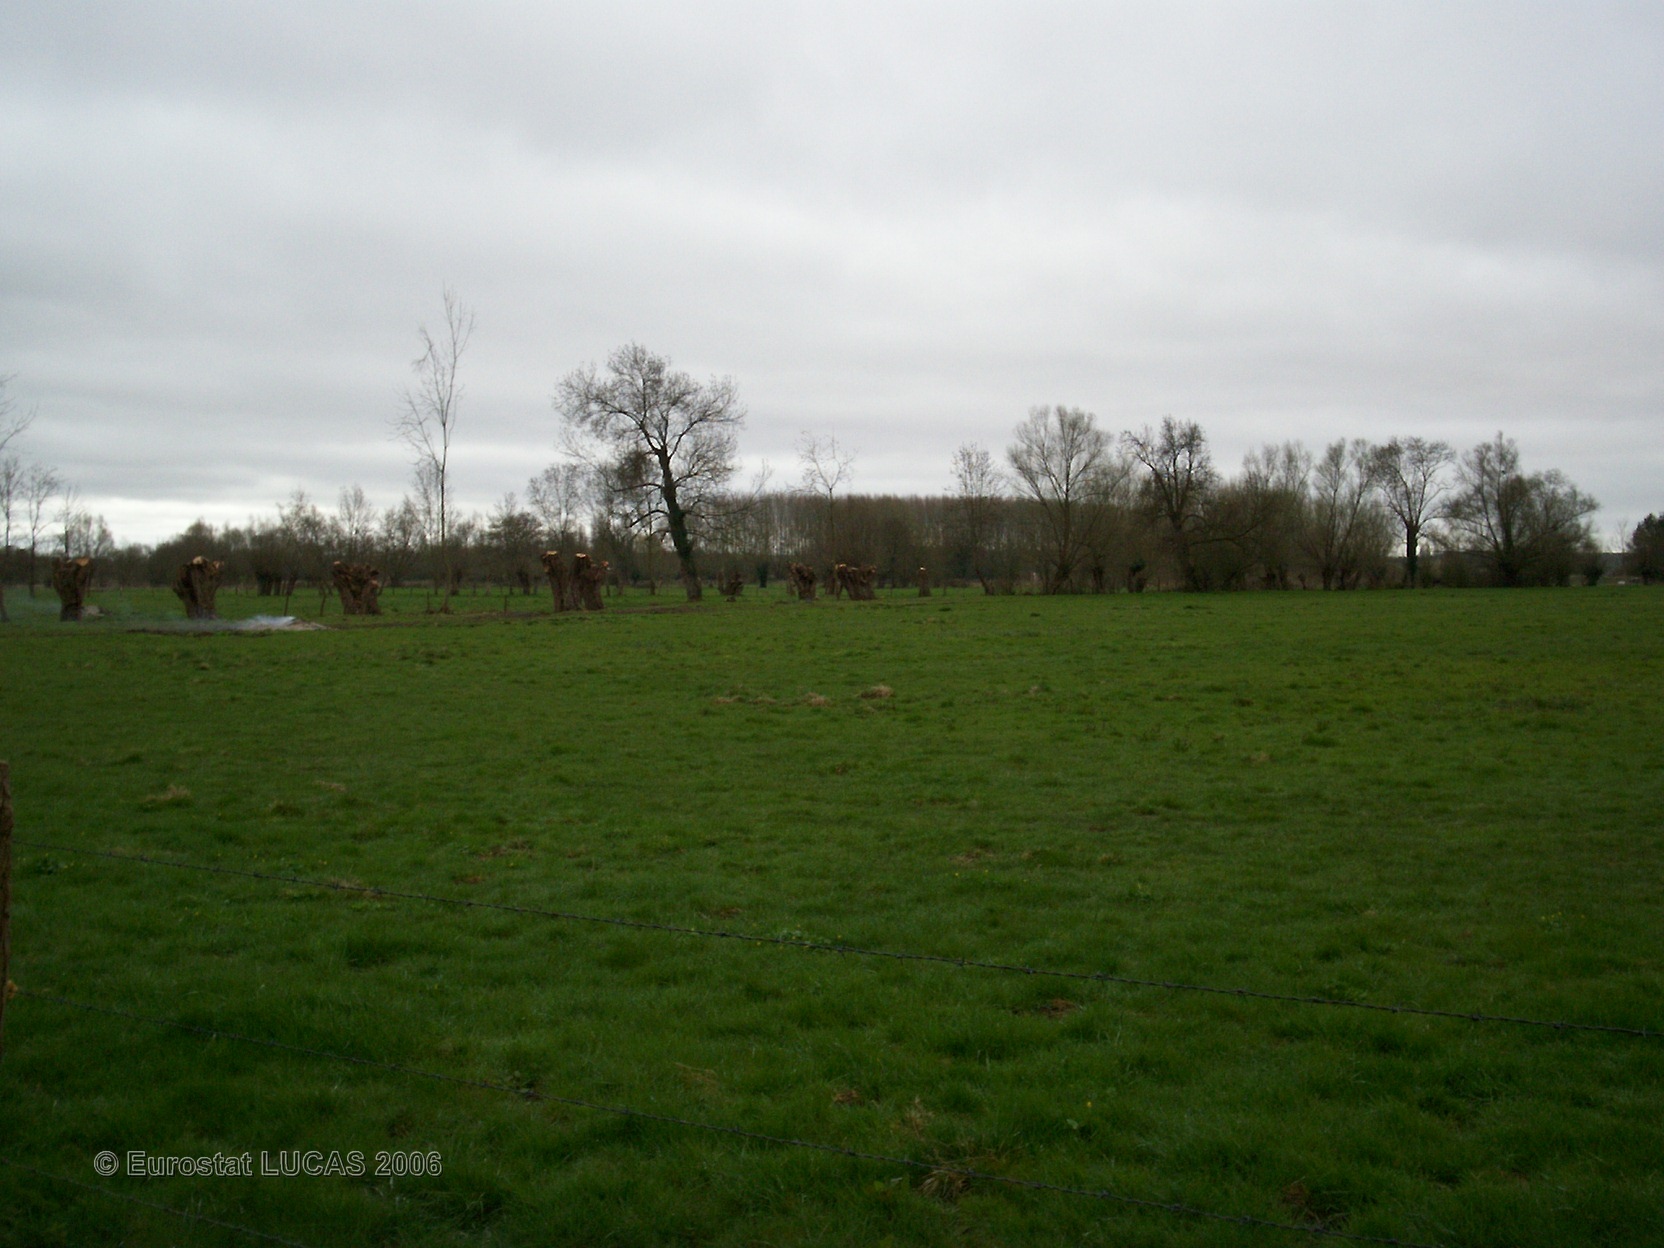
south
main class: Grassland
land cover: Grassland without tree/shrub cover
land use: Agriculture (excluding fallow land and kitchen gardens)
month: April
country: FR
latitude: 49.4788
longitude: 0.9369
